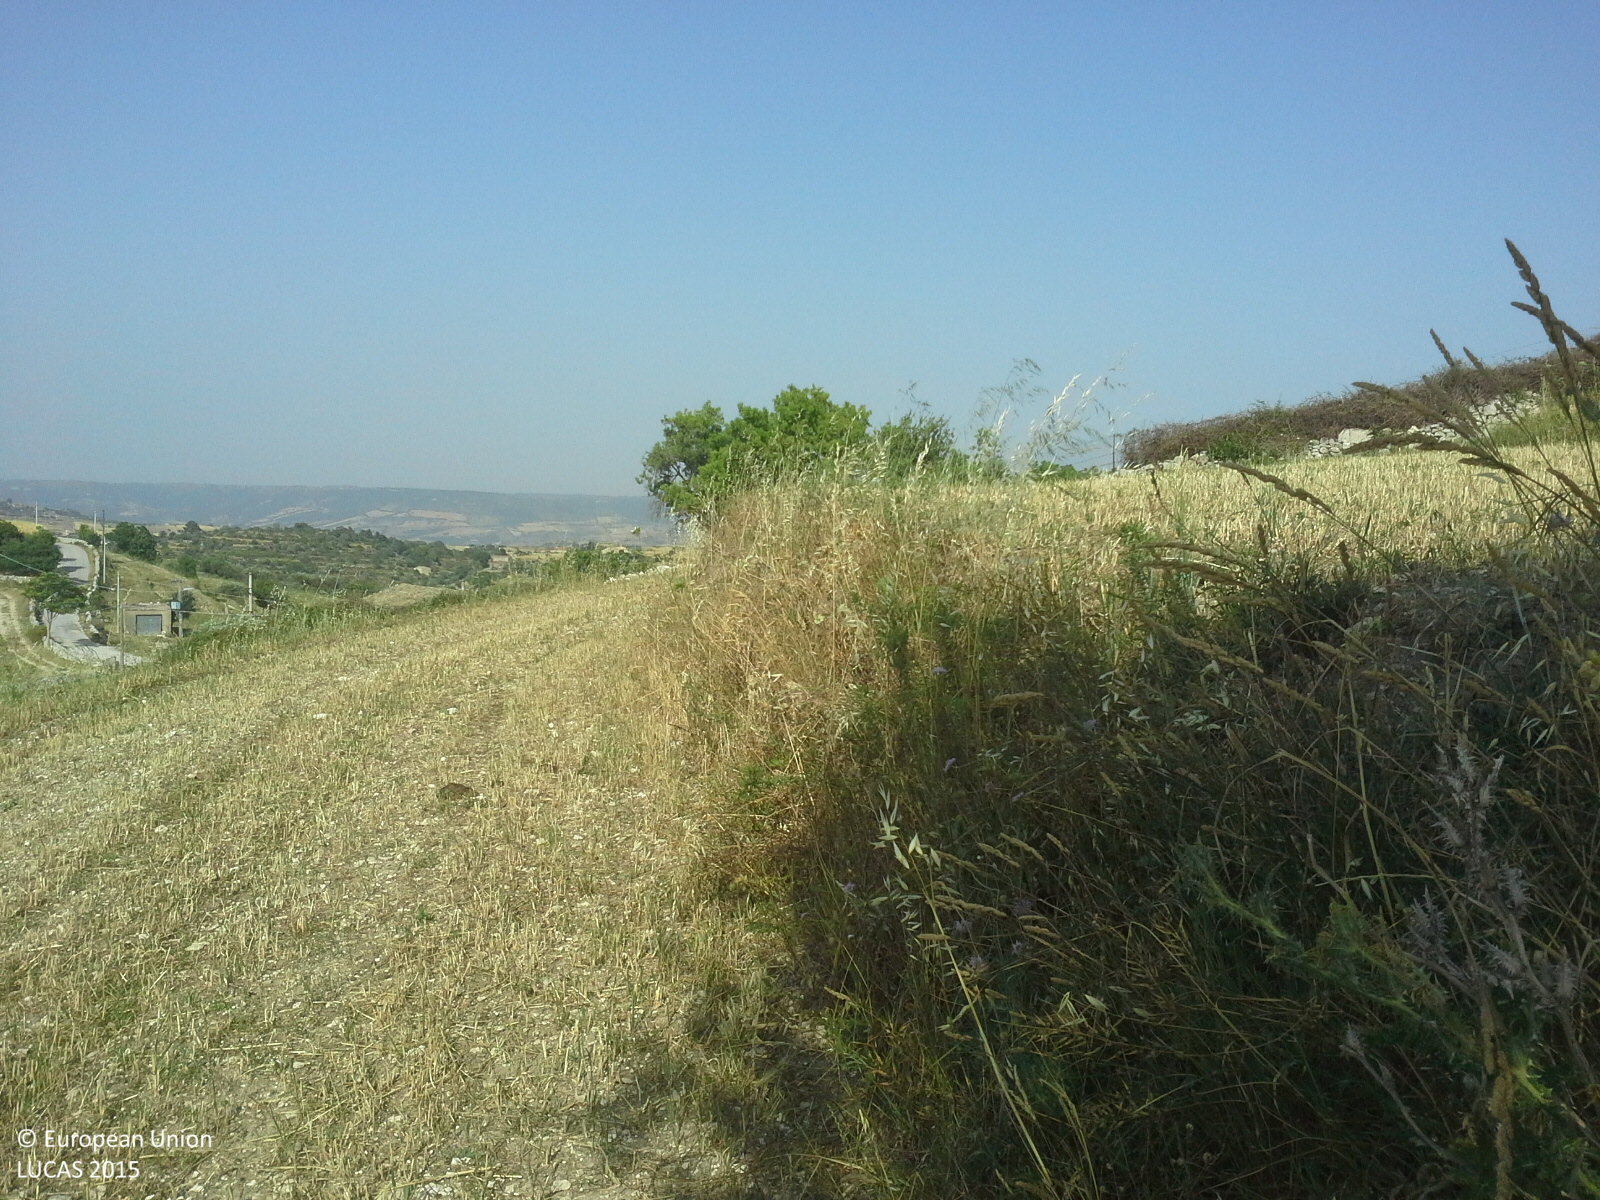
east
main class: Cropland
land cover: Mixed cereals for fodder
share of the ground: > 75 %
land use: Agriculture (excluding fallow land and kitchen gardens)
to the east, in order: Mixed cereals for fodder; Dry stone walls; Fences; Nuts trees; Mixed cereals for fodder; Artificial constructions in urban areas; Grass margins; Electric lines; Olive groves; Arable land (only in case pi); Permanent crops (only in case pi)
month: June
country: IT
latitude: 36.9713
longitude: 14.8036
